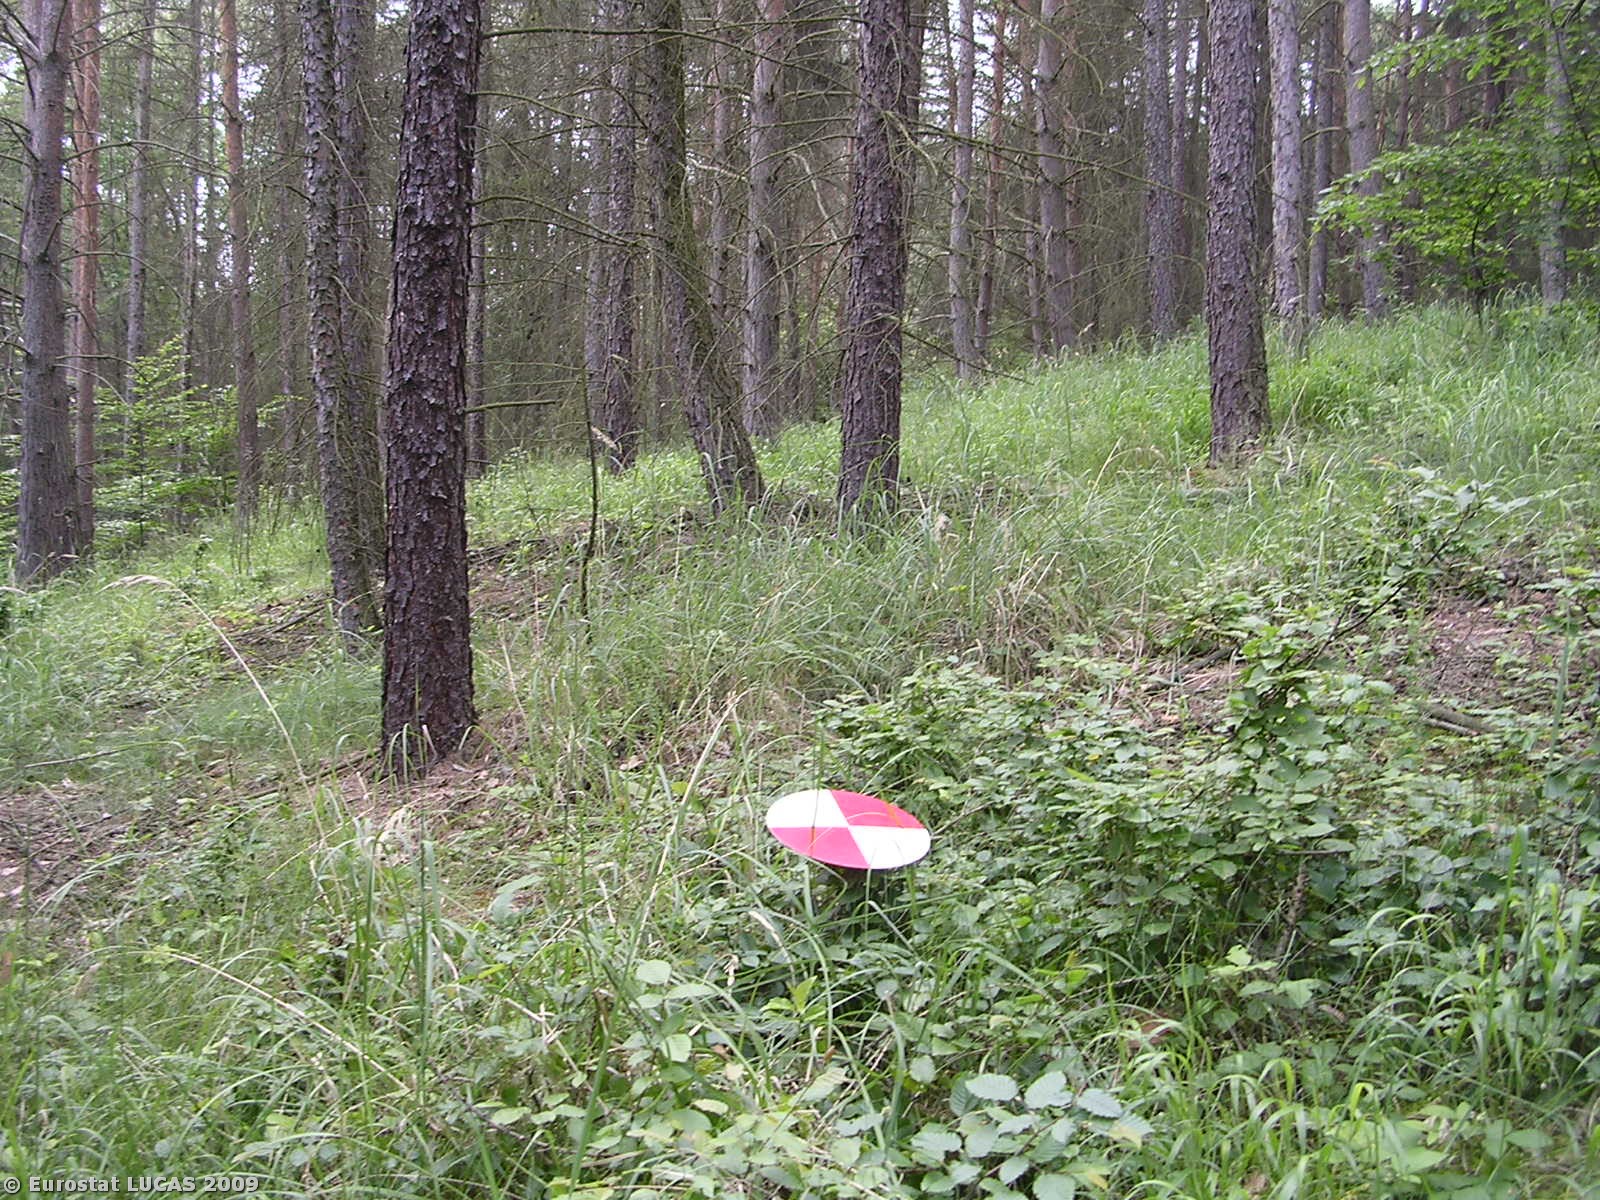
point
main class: Woodland
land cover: Coniferous woodland
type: hemiboreal forest and nemoral coniferous forest and mixed broadleaved-coniferous forest
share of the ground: > 75 %
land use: Forestry
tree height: > 5 m
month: June
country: CZ
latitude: 50.4727
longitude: 14.5248
